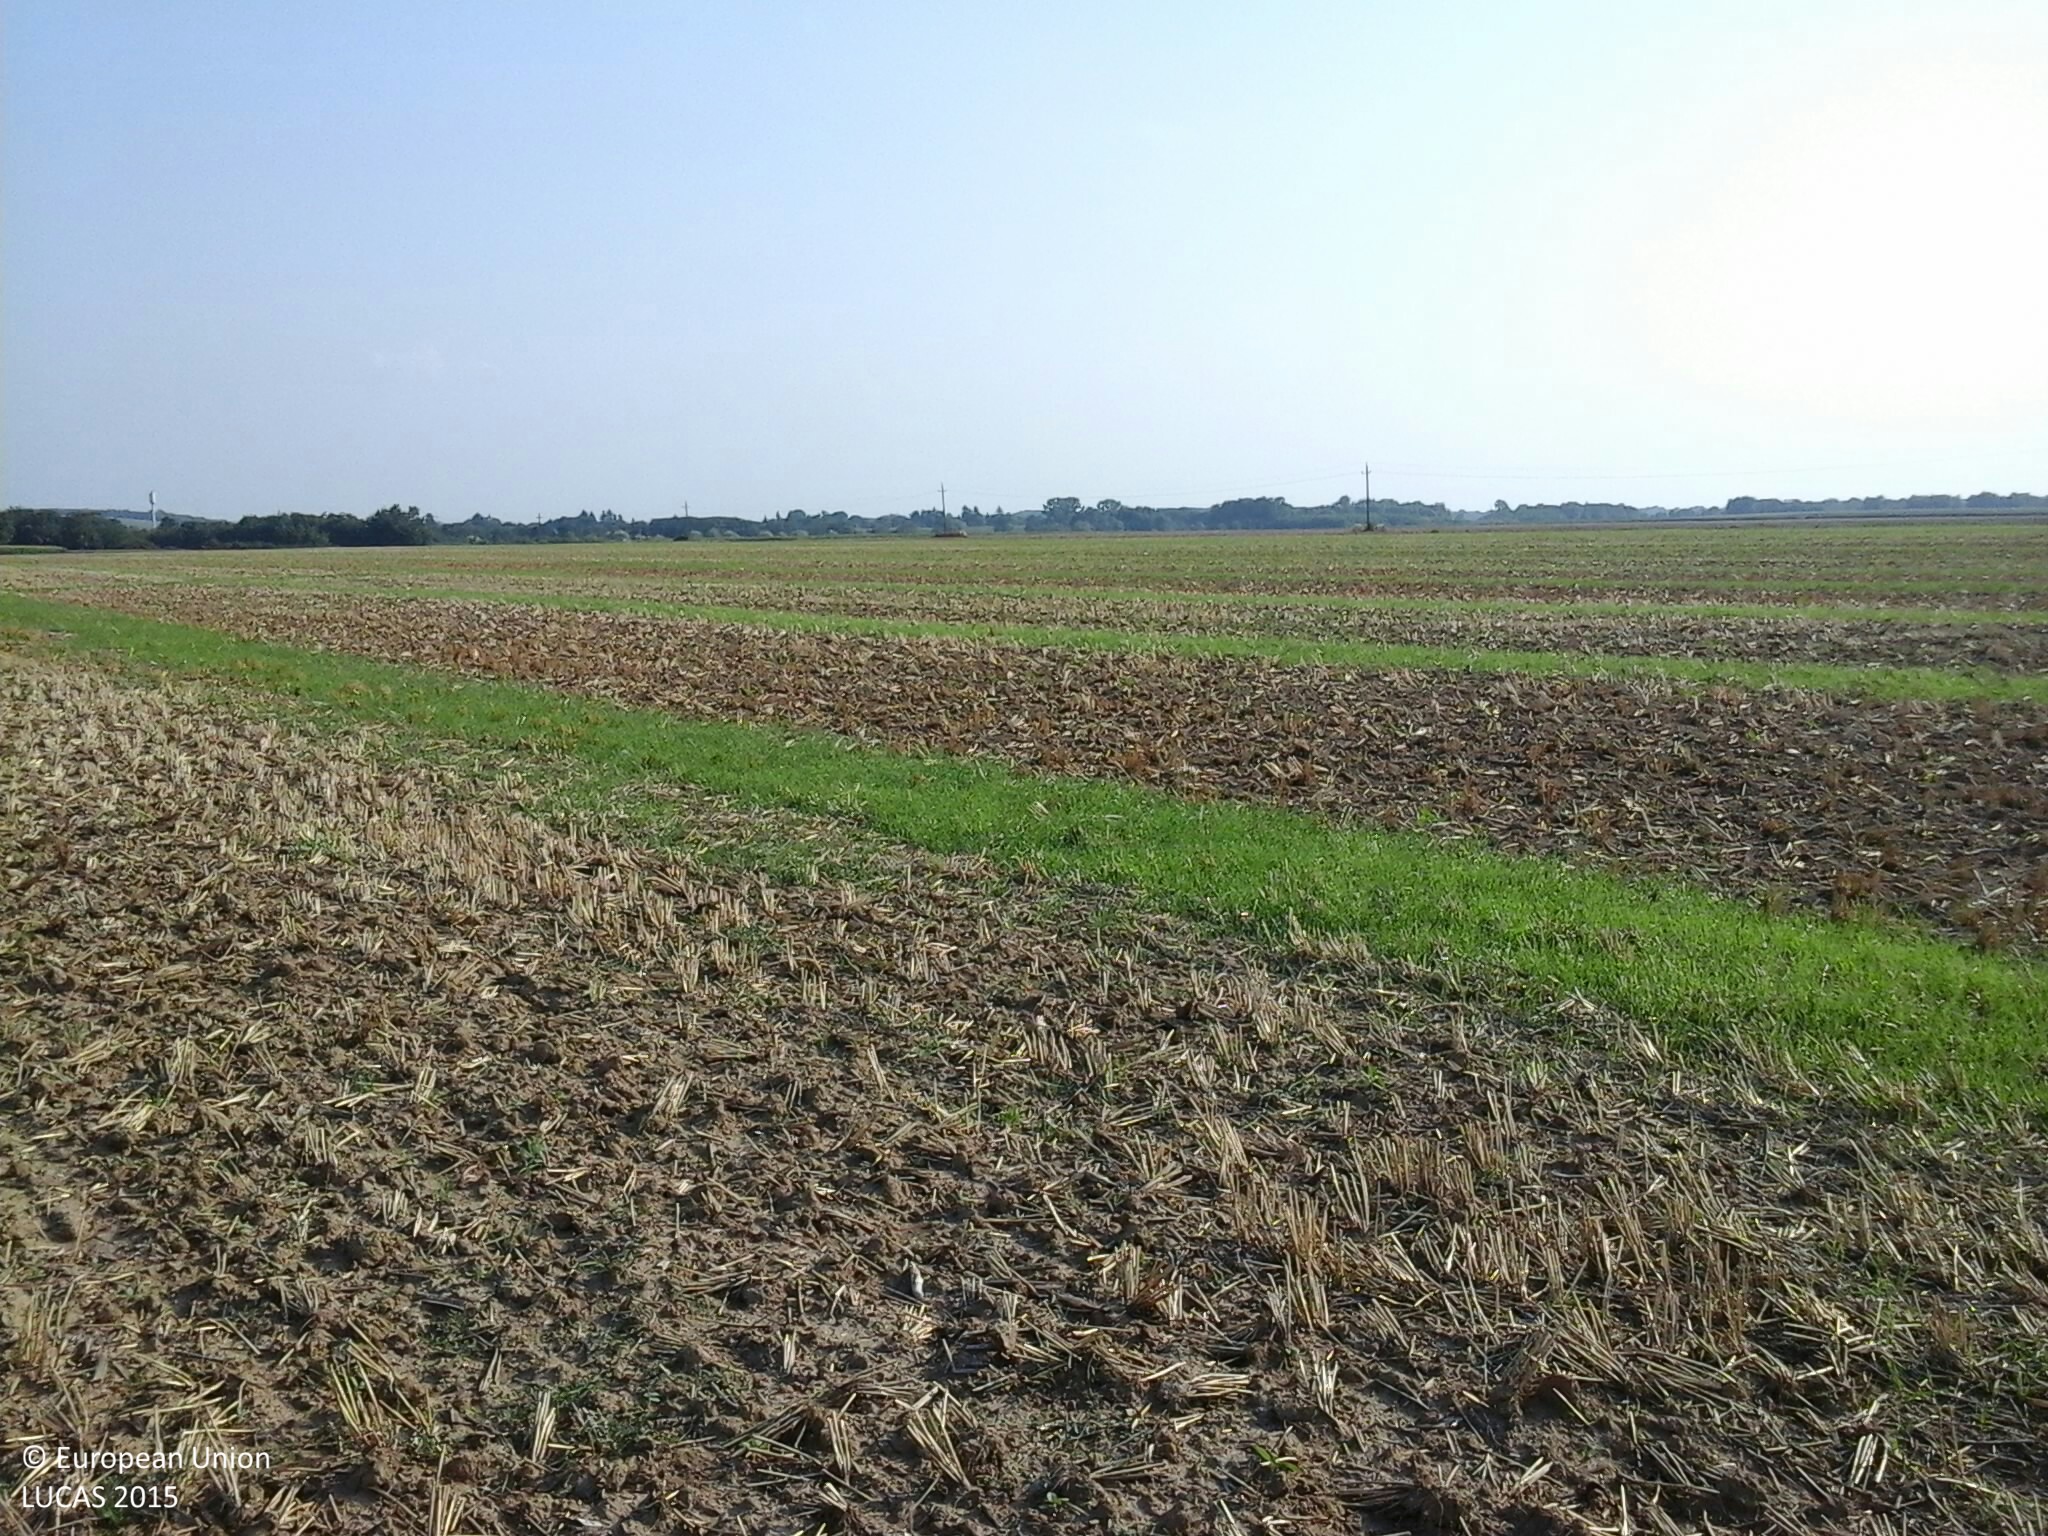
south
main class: Cropland
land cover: Common wheat
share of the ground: < 10 %
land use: Agriculture (excluding fallow land and kitchen gardens)
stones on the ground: < 10 %
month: August
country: HU
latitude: 45.9177
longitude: 18.0899
